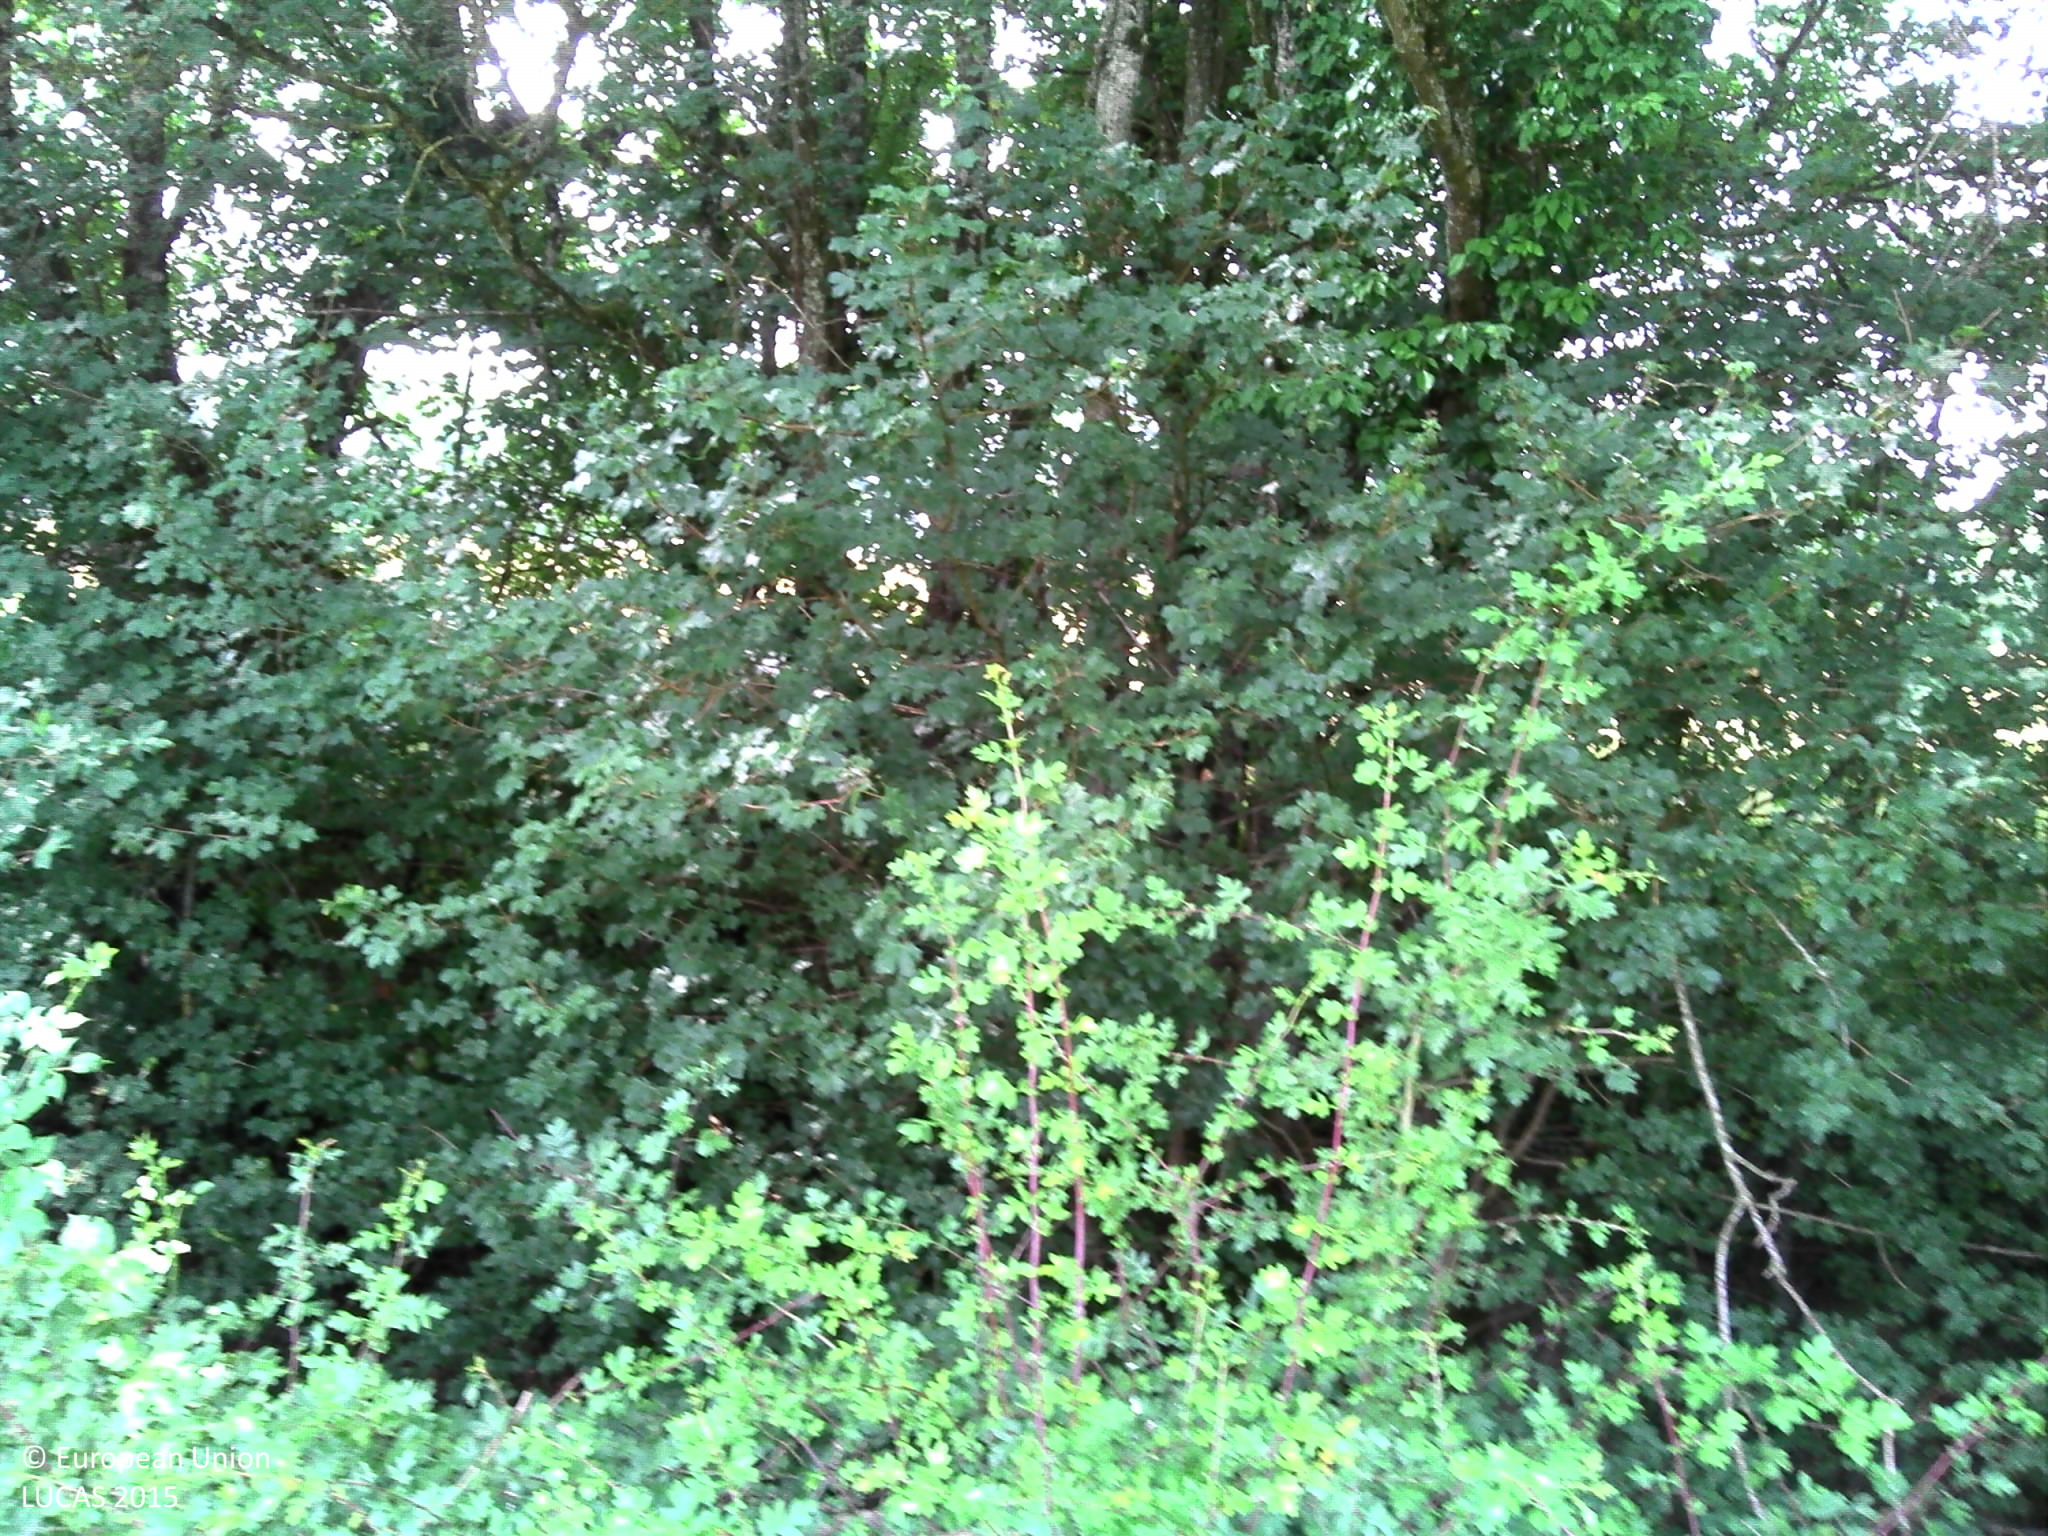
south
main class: Grassland
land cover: Grassland without tree/shrub cover
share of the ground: > 75 %
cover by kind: herbaceous plants 100 %
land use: Agriculture (excluding fallow land and kitchen gardens)
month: July
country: FR
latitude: 47.1124
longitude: 3.5265
